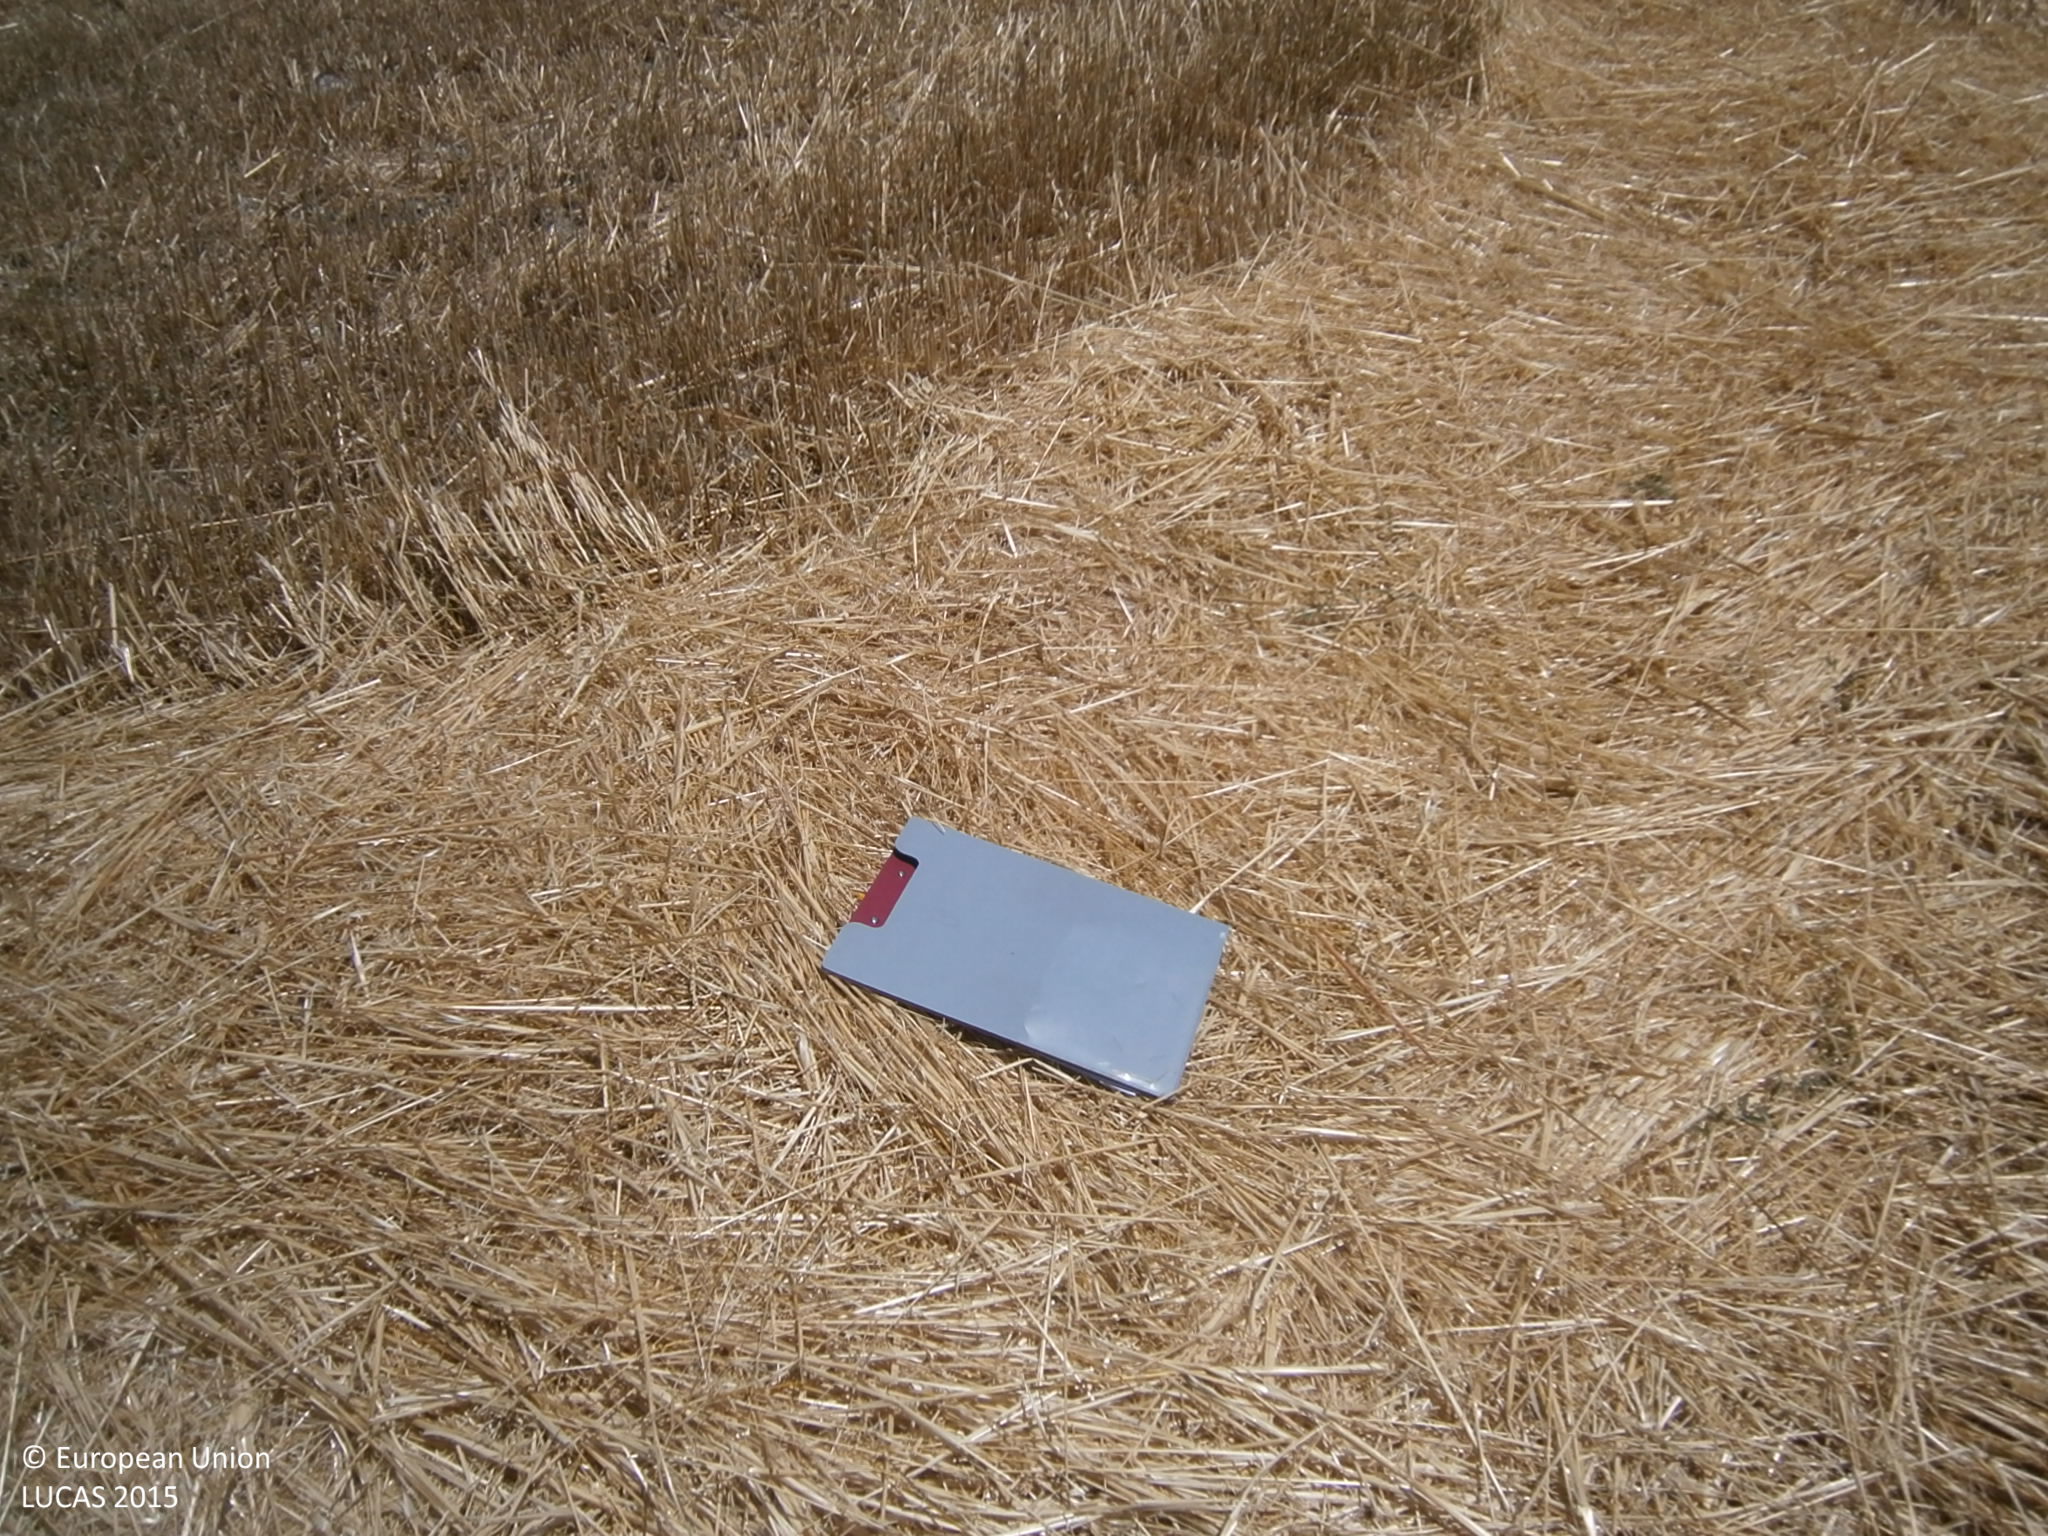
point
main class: Cropland
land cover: Oats
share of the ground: > 75 %
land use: Agriculture (excluding fallow land and kitchen gardens)
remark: Harvested field
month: June
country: ES
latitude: 38.6561
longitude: -6.9224
